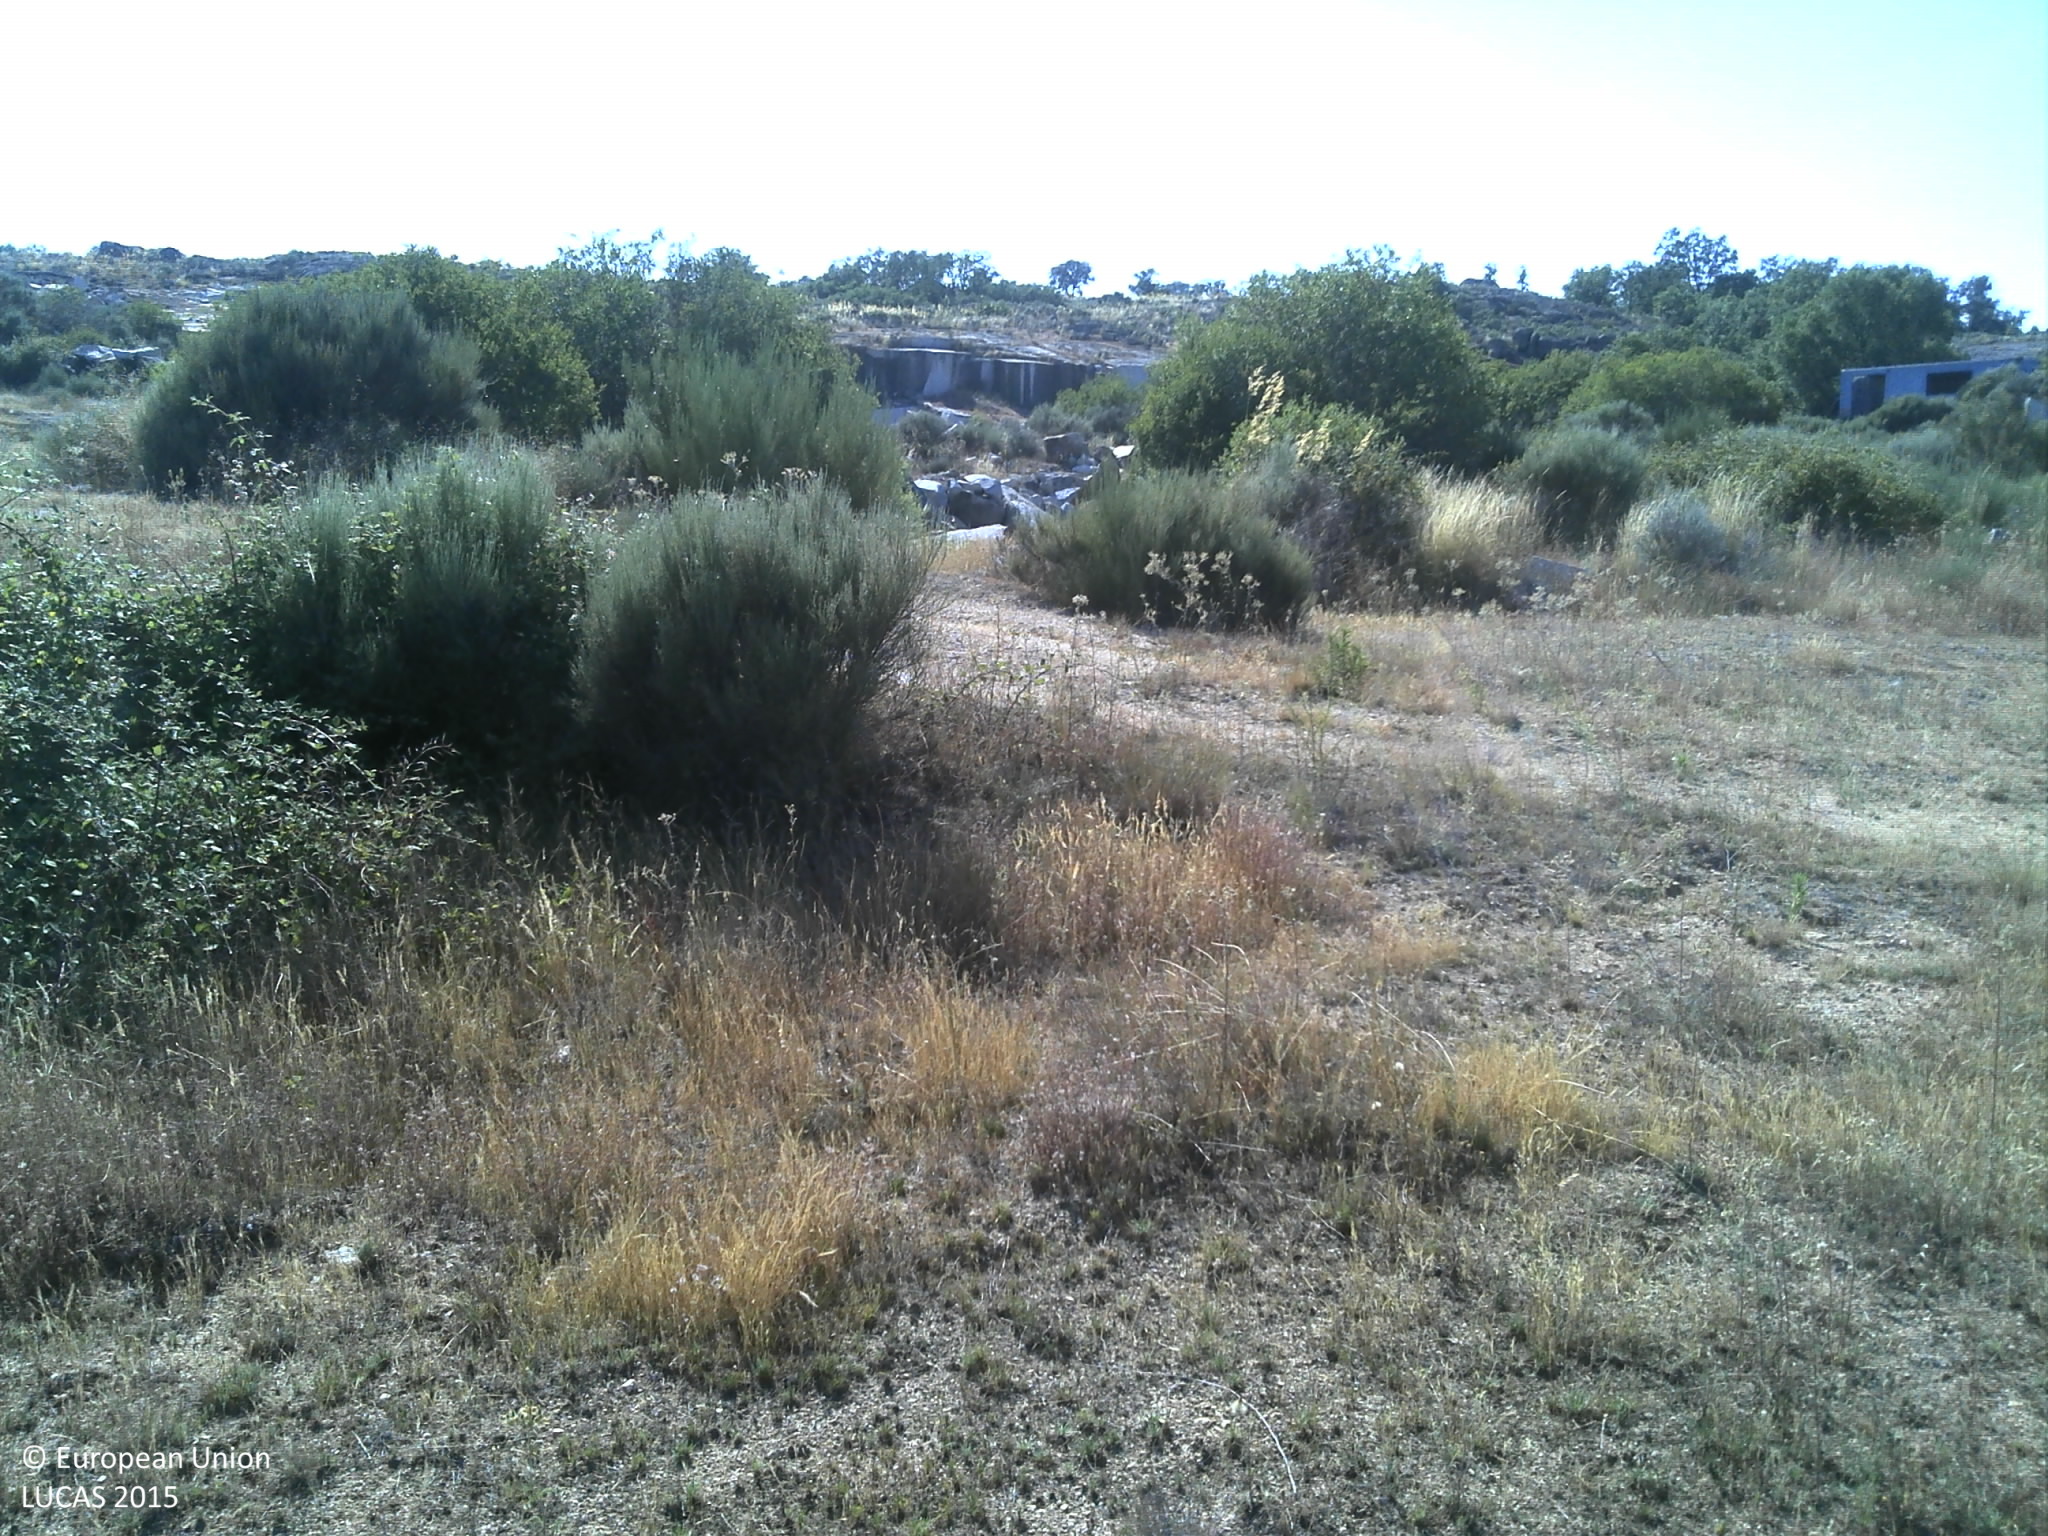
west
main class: Shrubland
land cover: Shrubland without tree cover
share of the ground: 25 - 50 %
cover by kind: unconsolidated bare surface 40 %, herbaceous plants 30 %, shrubs 25 %, consolidated bare surface 5 %
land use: Abandoned areas
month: June
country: PT
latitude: 40.7677
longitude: -6.8634
